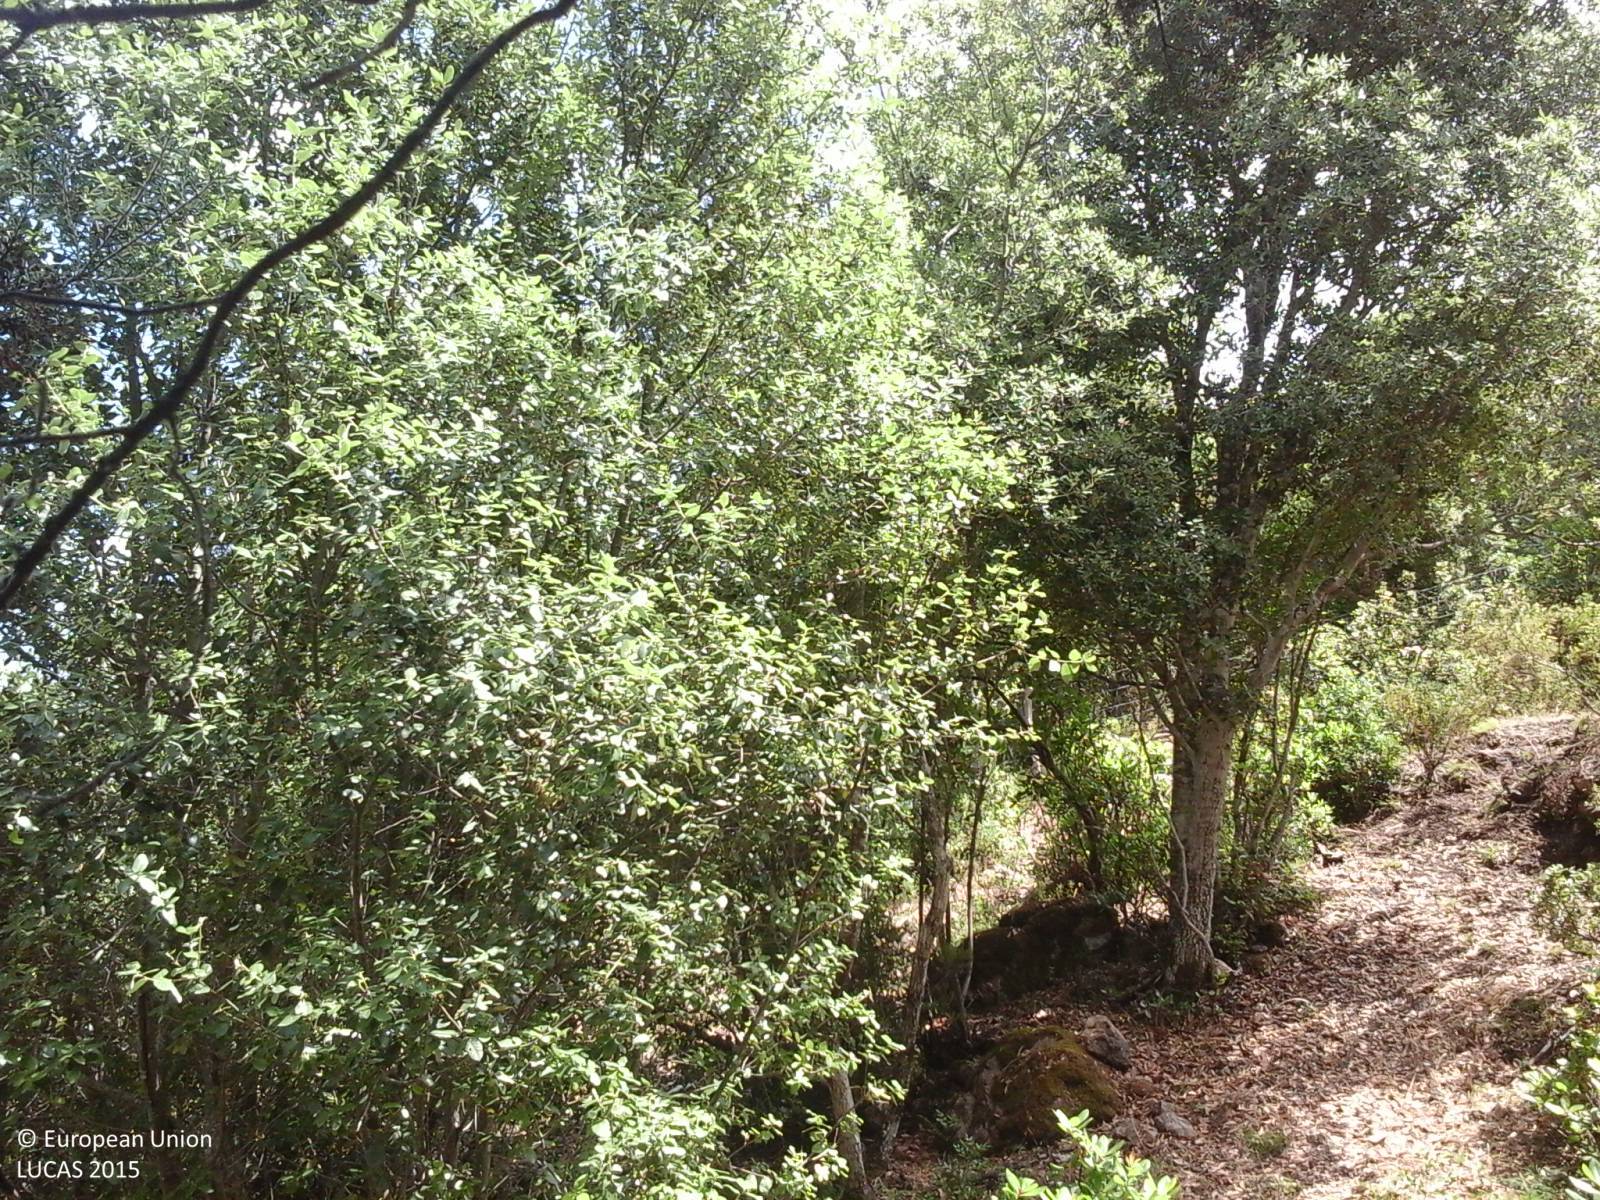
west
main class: Woodland
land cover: Broadleaved woodland
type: broadleaved evergreen forest
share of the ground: > 75 %
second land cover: Grassland without tree/shrub cover
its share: > 75 %
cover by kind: broadleaved forest trees 75 %, herbaceous plants 25 %
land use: Forestry
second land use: Agriculture (excluding fallow land and kitchen gardens)
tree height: > 5 m
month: June
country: IT
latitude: 40.6820
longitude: 9.4466
